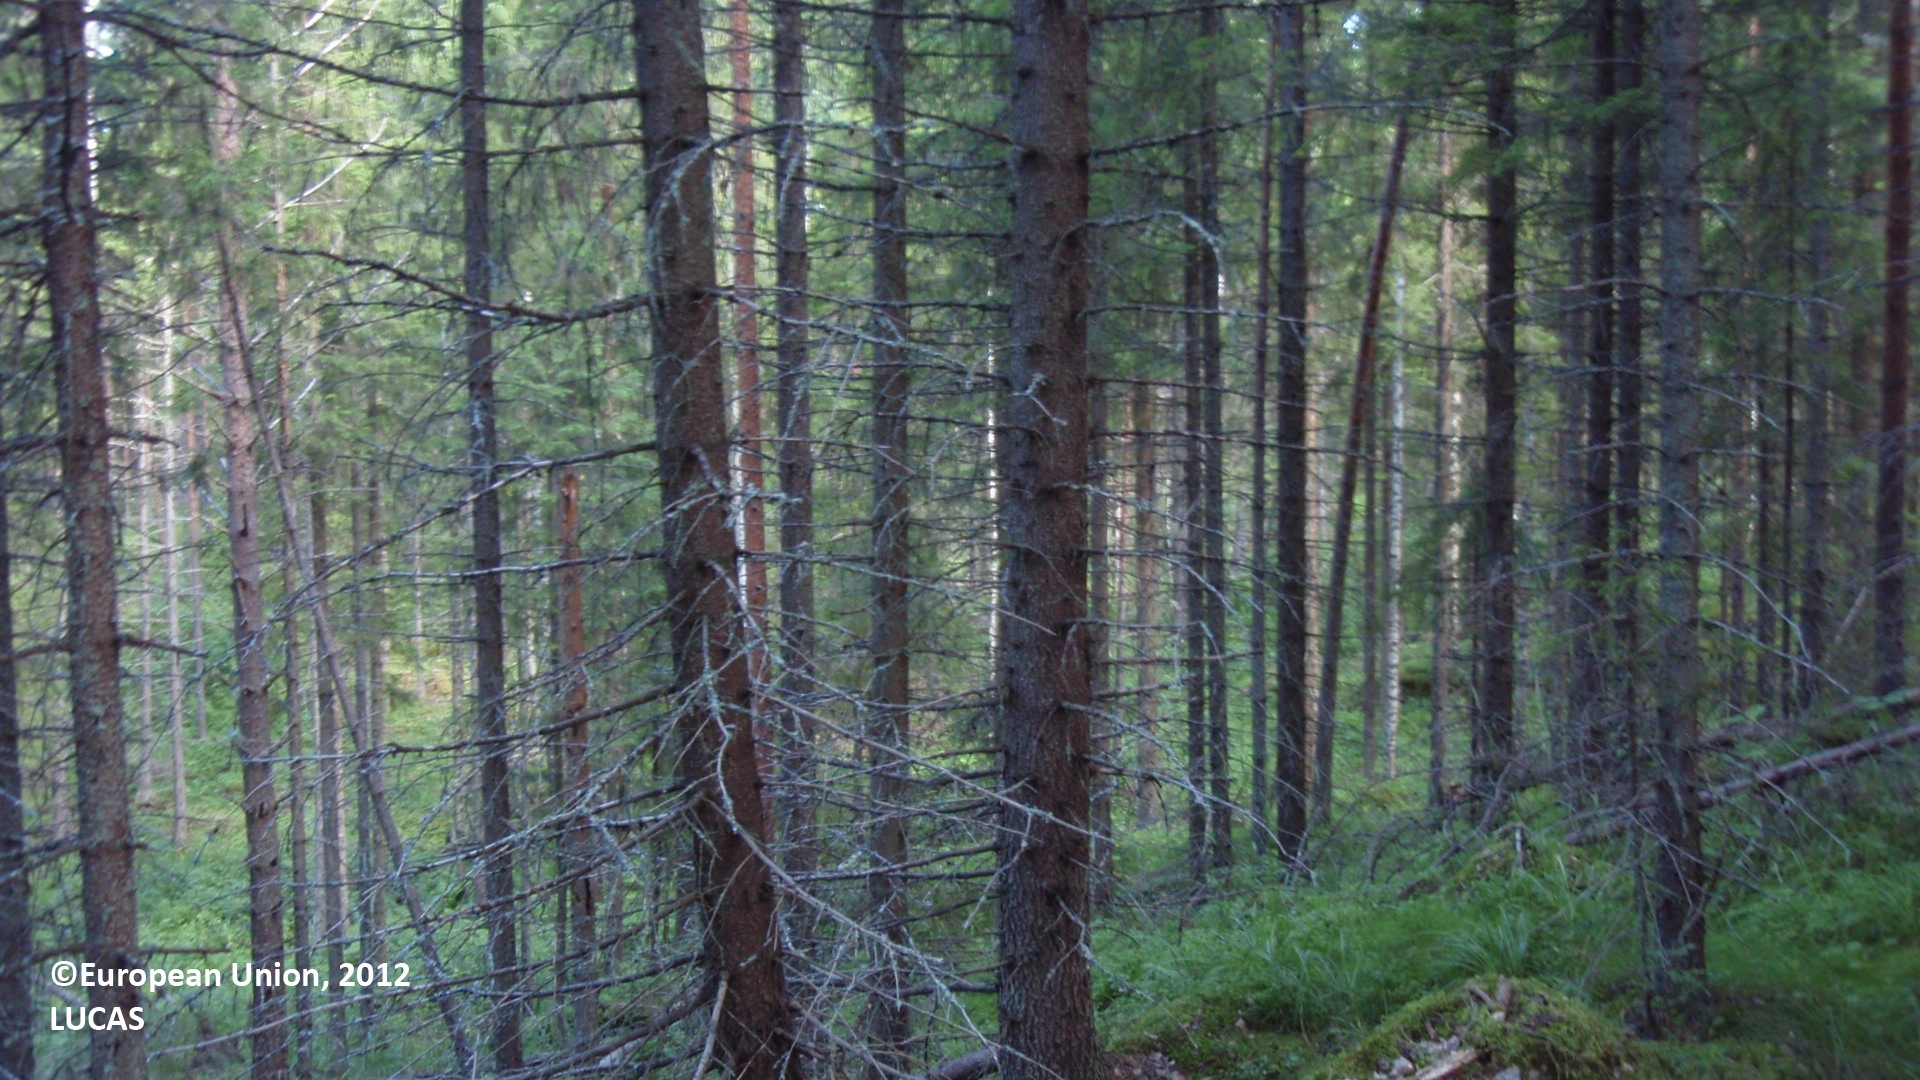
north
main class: Woodland
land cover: Spruce dominated coniferous woodland
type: boreal forest
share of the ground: 50 - 75 %
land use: Forestry
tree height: > 5 m
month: July
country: FI
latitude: 61.5954
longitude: 28.0794
